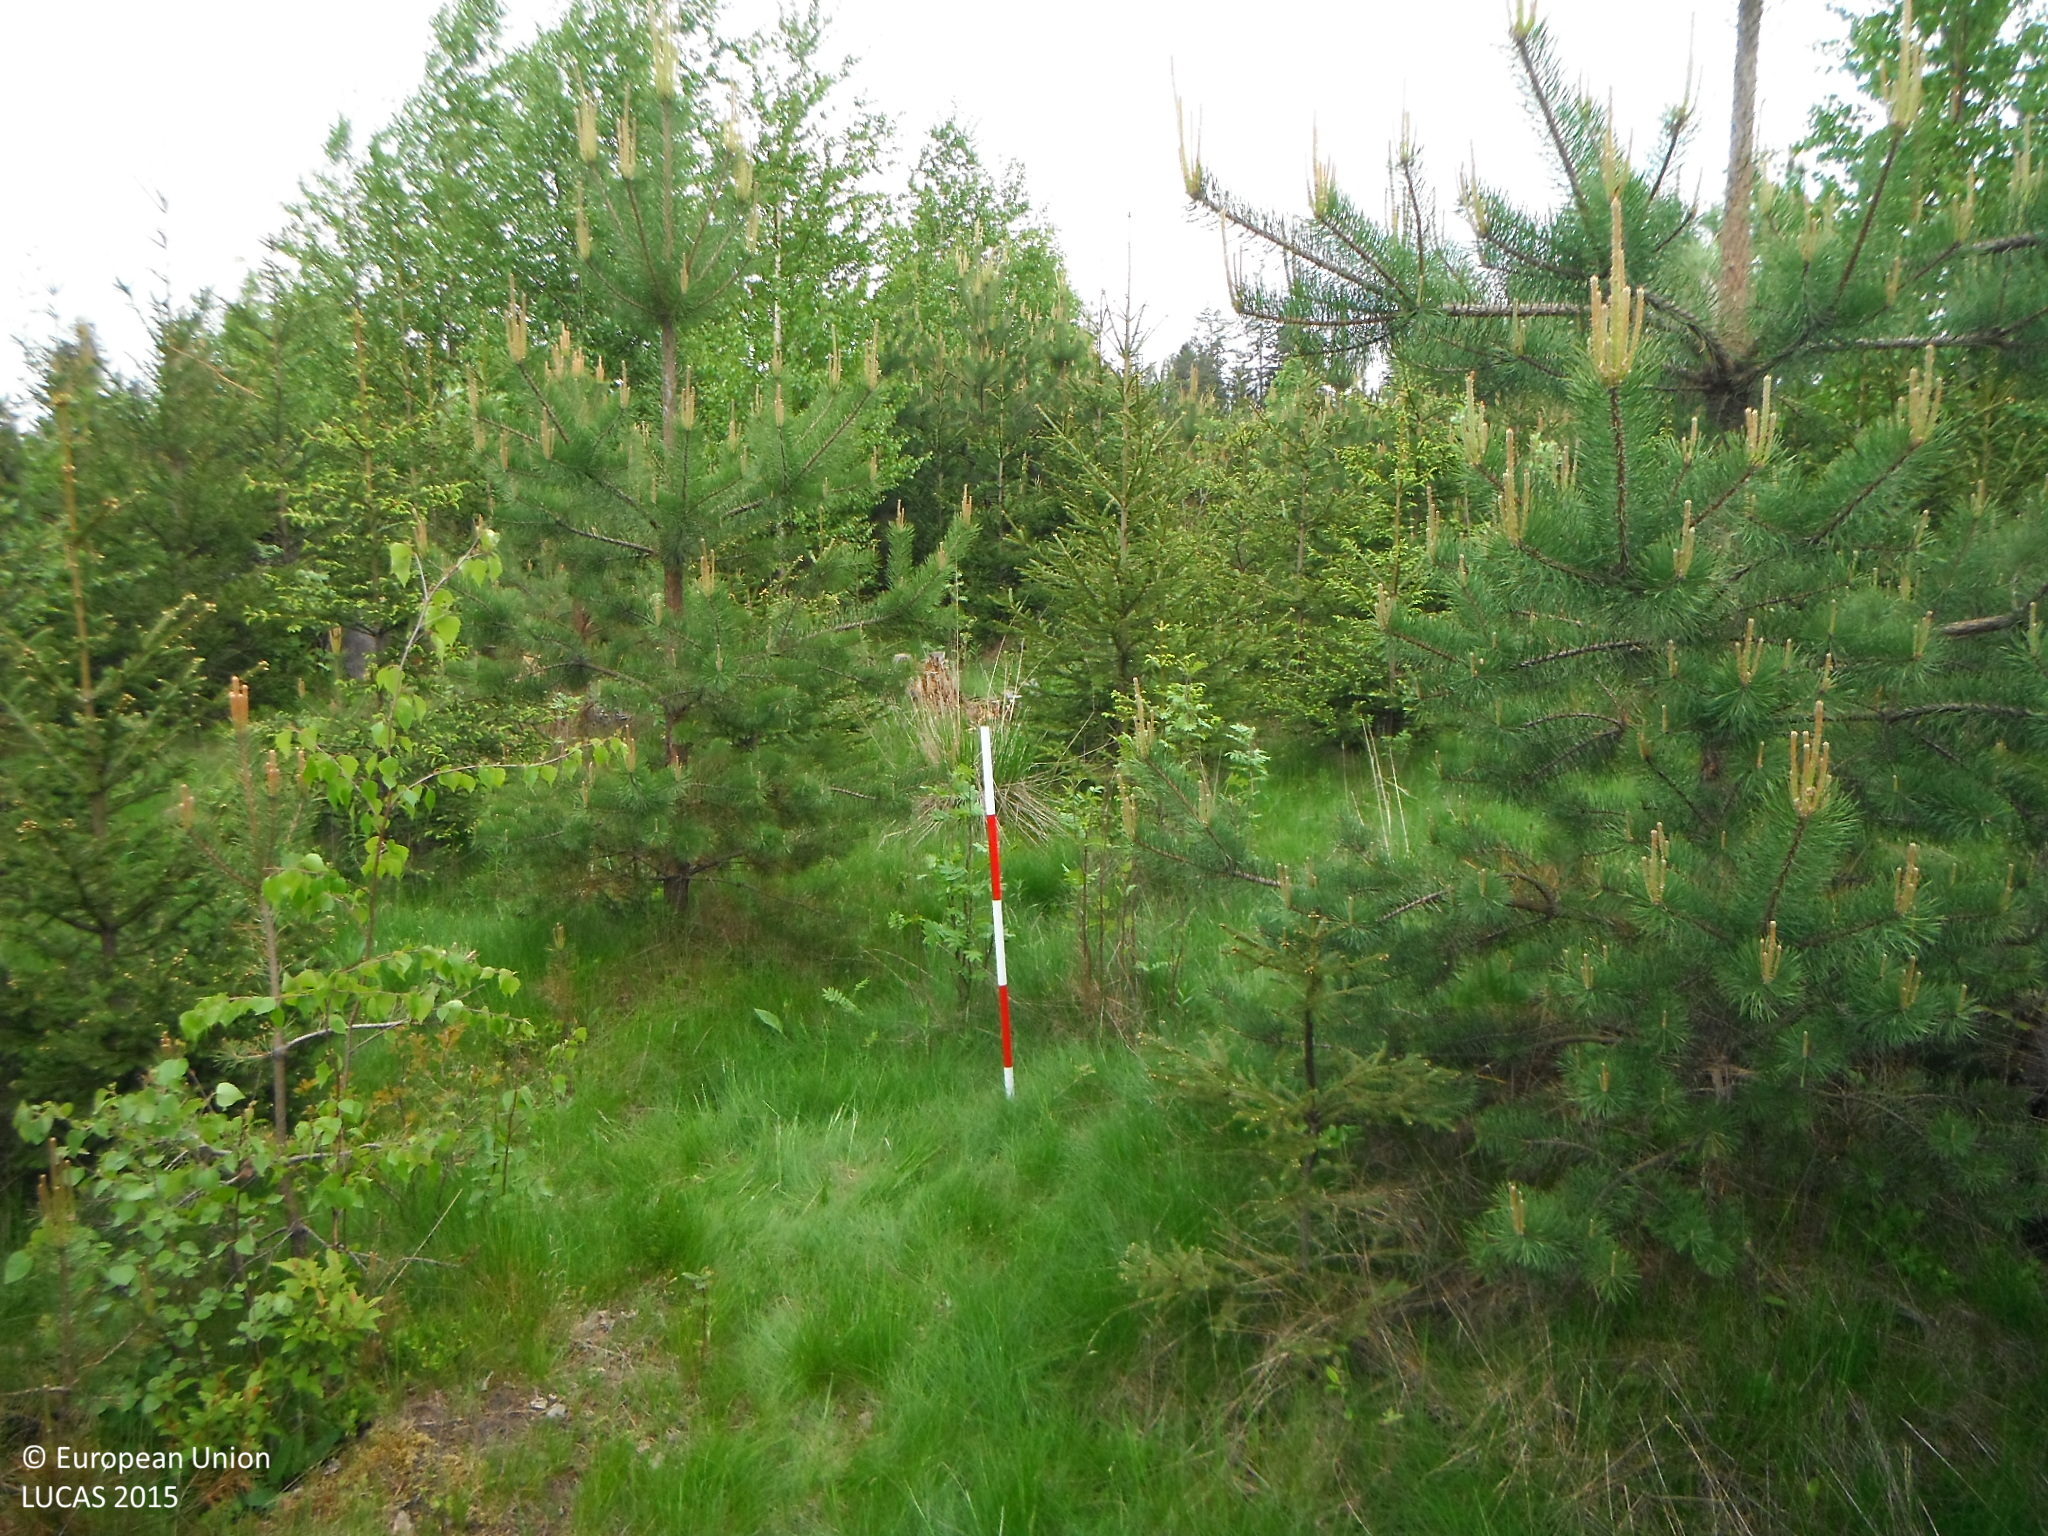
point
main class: Woodland
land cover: Pine dominated mixed woodland
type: alpine coniferous forest
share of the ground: > 75 %
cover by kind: coniferous forest trees 50 %, broadleaved forest trees 25 %, herbaceous plants 15 %, lichens and mosses 5 %, consolidated bare surface 5 %
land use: Forestry
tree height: < 5 m
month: May
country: SK
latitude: 49.2227
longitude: 20.3462
